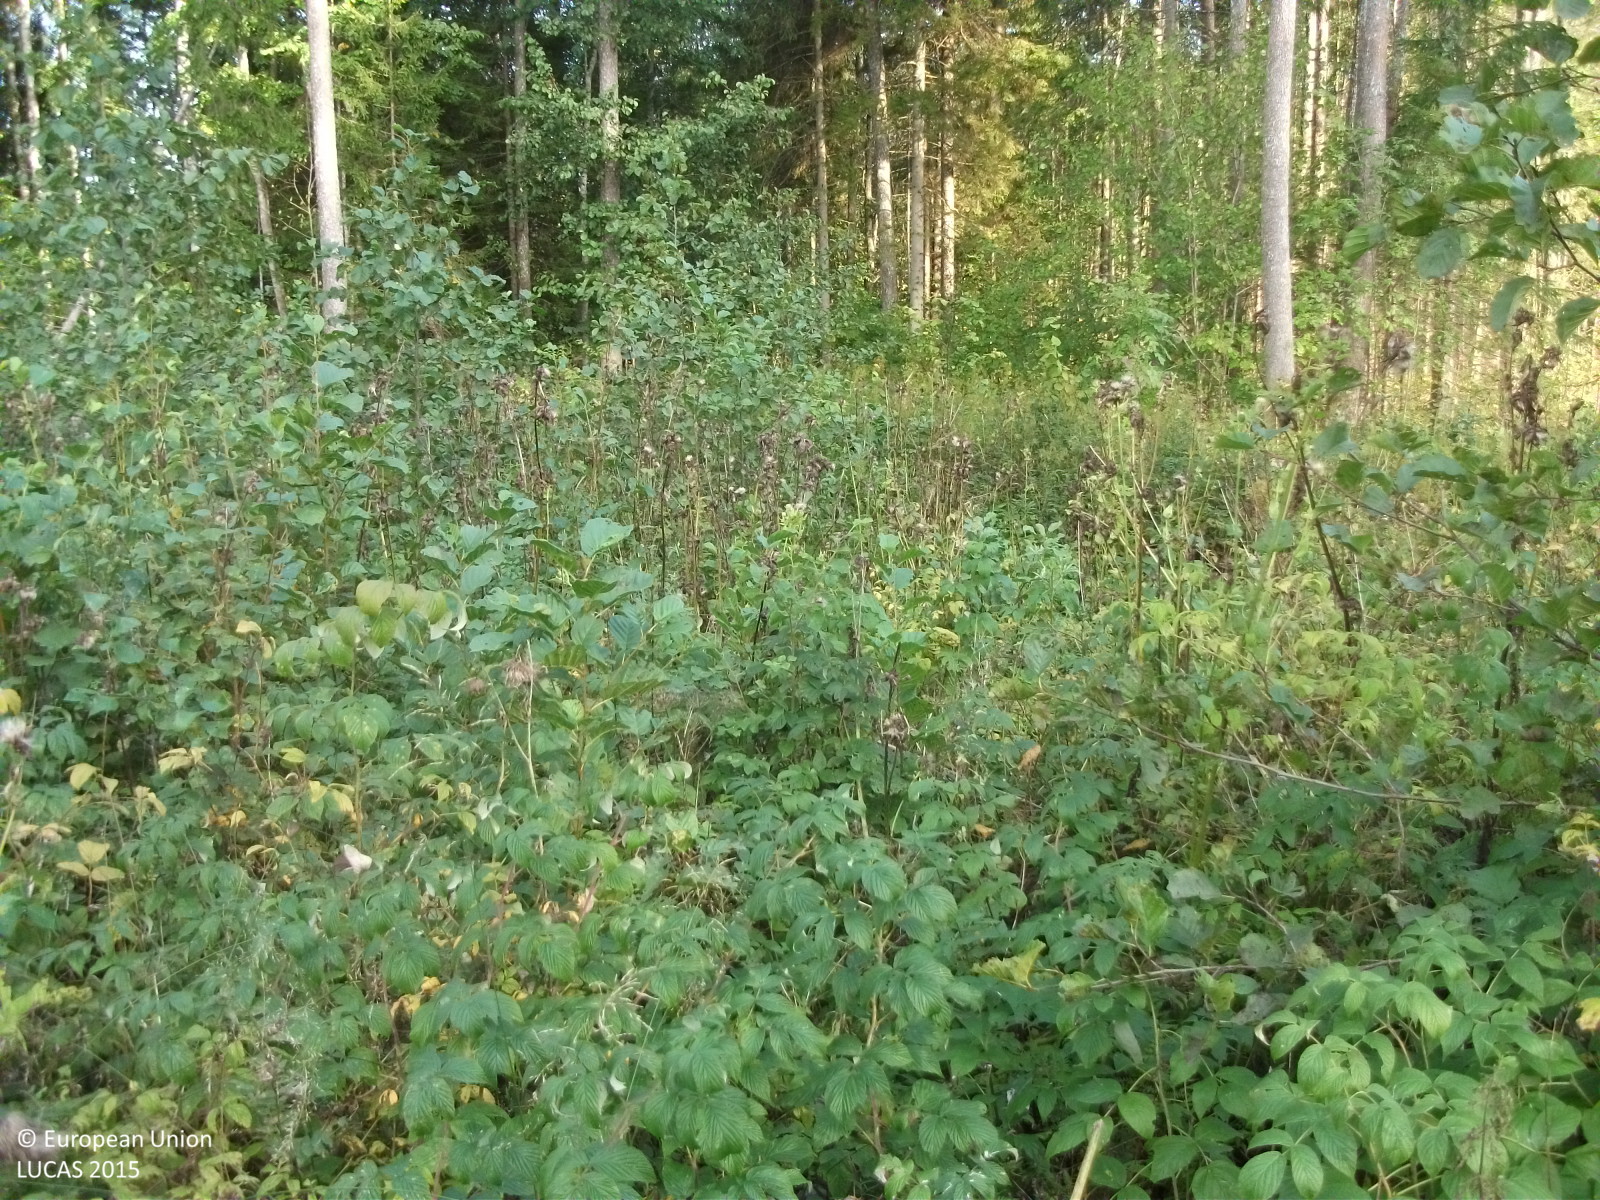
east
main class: Woodland
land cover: Broadleaved woodland
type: non-riverine alder, birch or aspen forest
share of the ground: 50 - 75 %
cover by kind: broadleaved forest trees 50 %, shrubs 35 %, herbaceous plants 10 %, coniferous forest trees 5 %
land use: Forestry
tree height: < 5 m
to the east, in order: Broadleaved woodland; Other mixed woodland; Broadleaved woodland
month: September
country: LV
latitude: 57.6065
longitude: 24.5344
